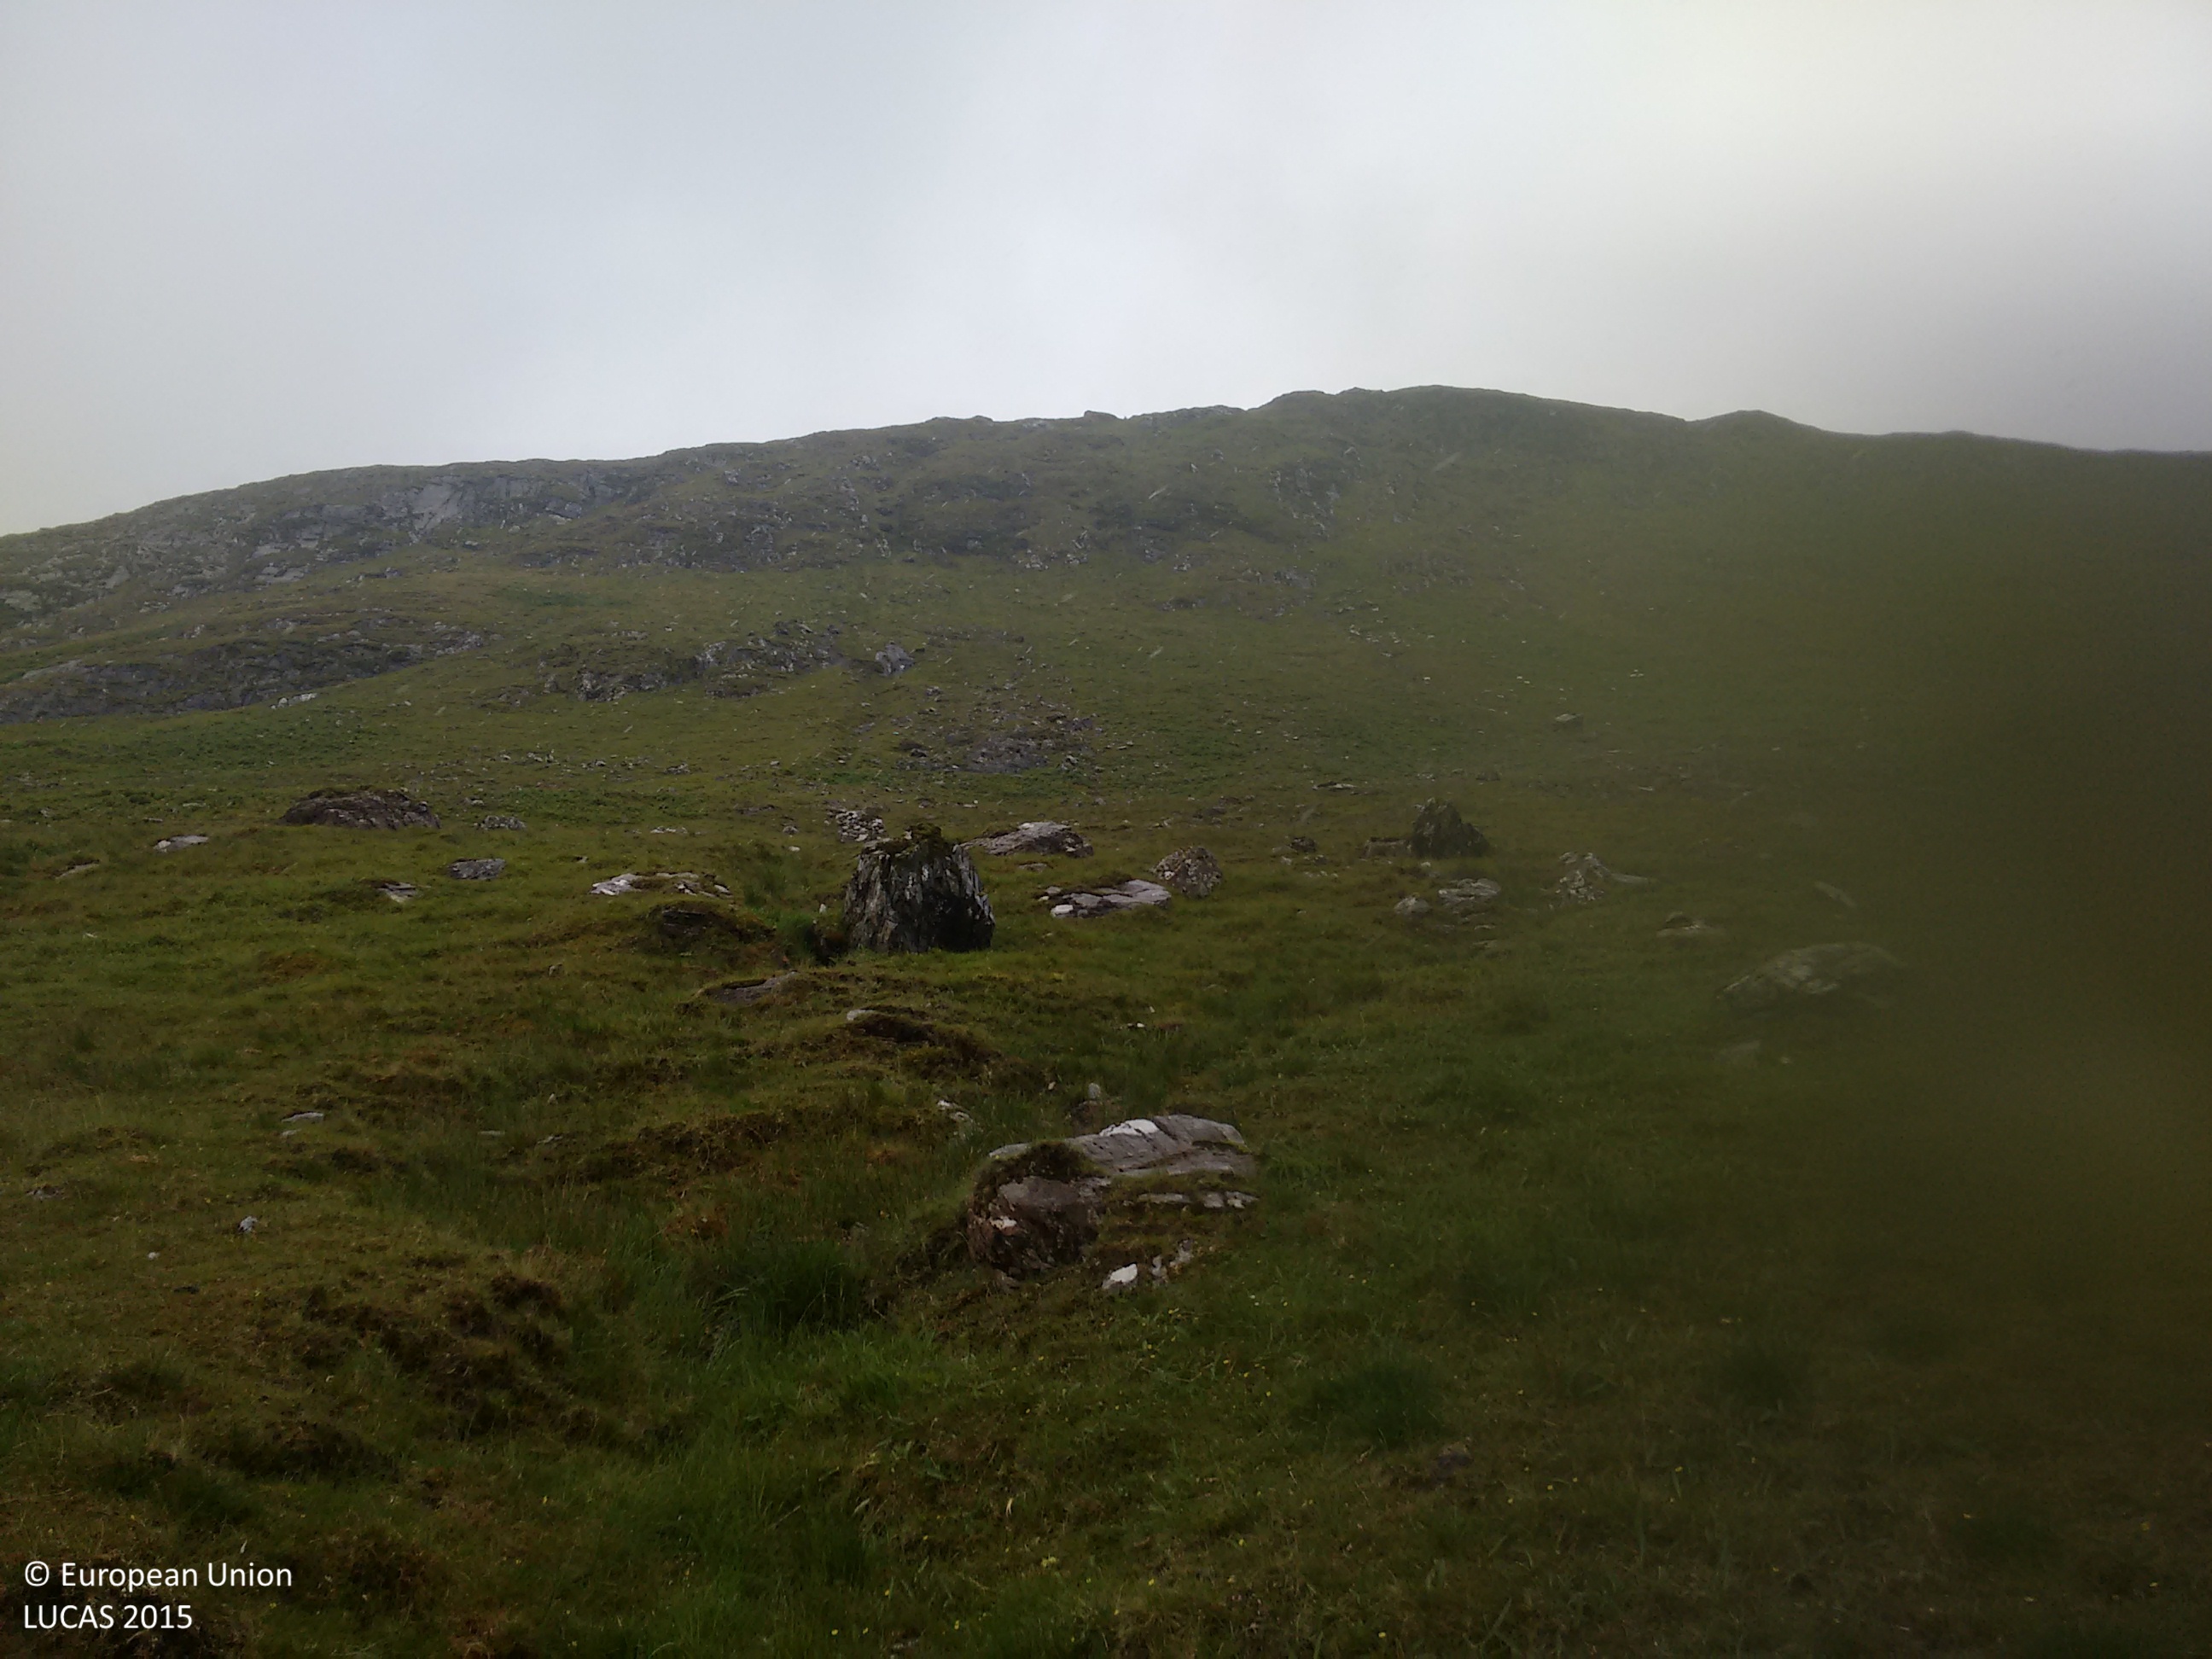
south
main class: Grassland
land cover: Grassland without tree/shrub cover
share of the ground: > 75 %
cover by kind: herbaceous plants 100 %
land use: Agriculture (excluding fallow land and kitchen gardens)
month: July
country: IE
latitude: 53.5289
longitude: -9.6543
